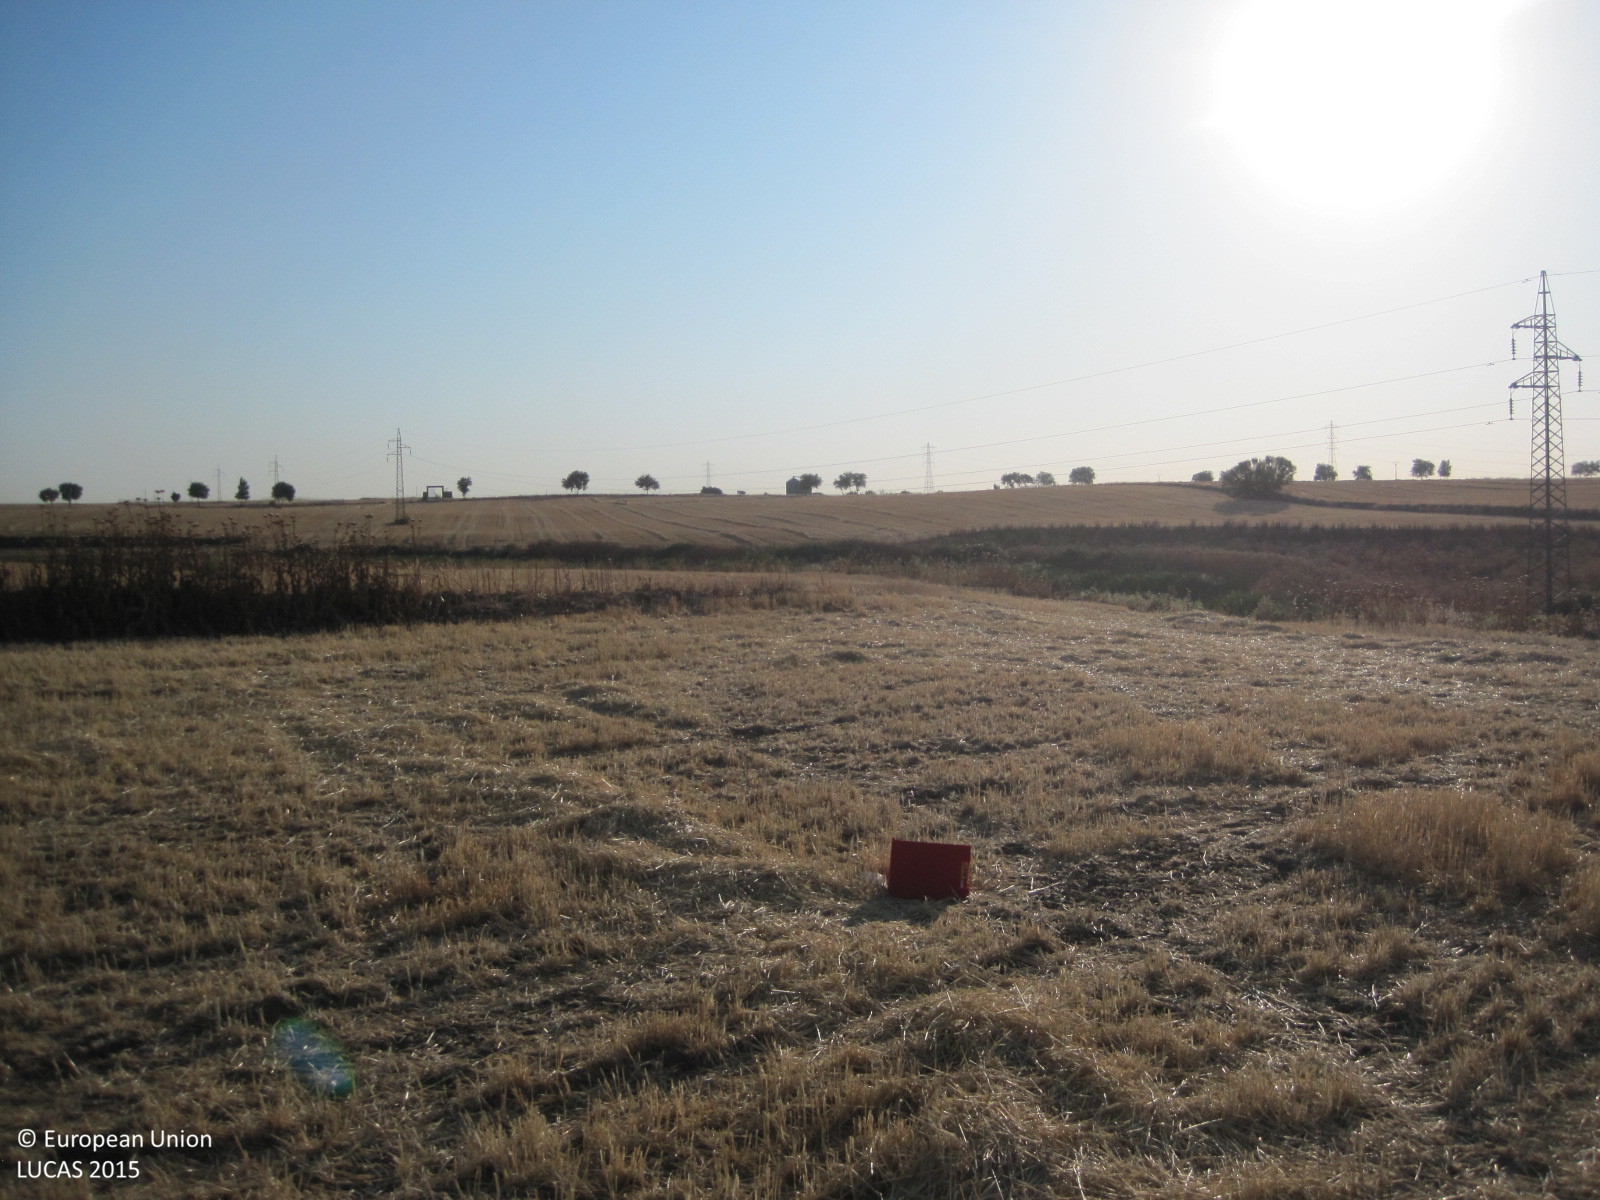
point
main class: Cropland
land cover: Barley
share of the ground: < 10 %
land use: Agriculture (excluding fallow land and kitchen gardens)
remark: Harvested field
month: July
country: ES
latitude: 40.1653
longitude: -3.8085
